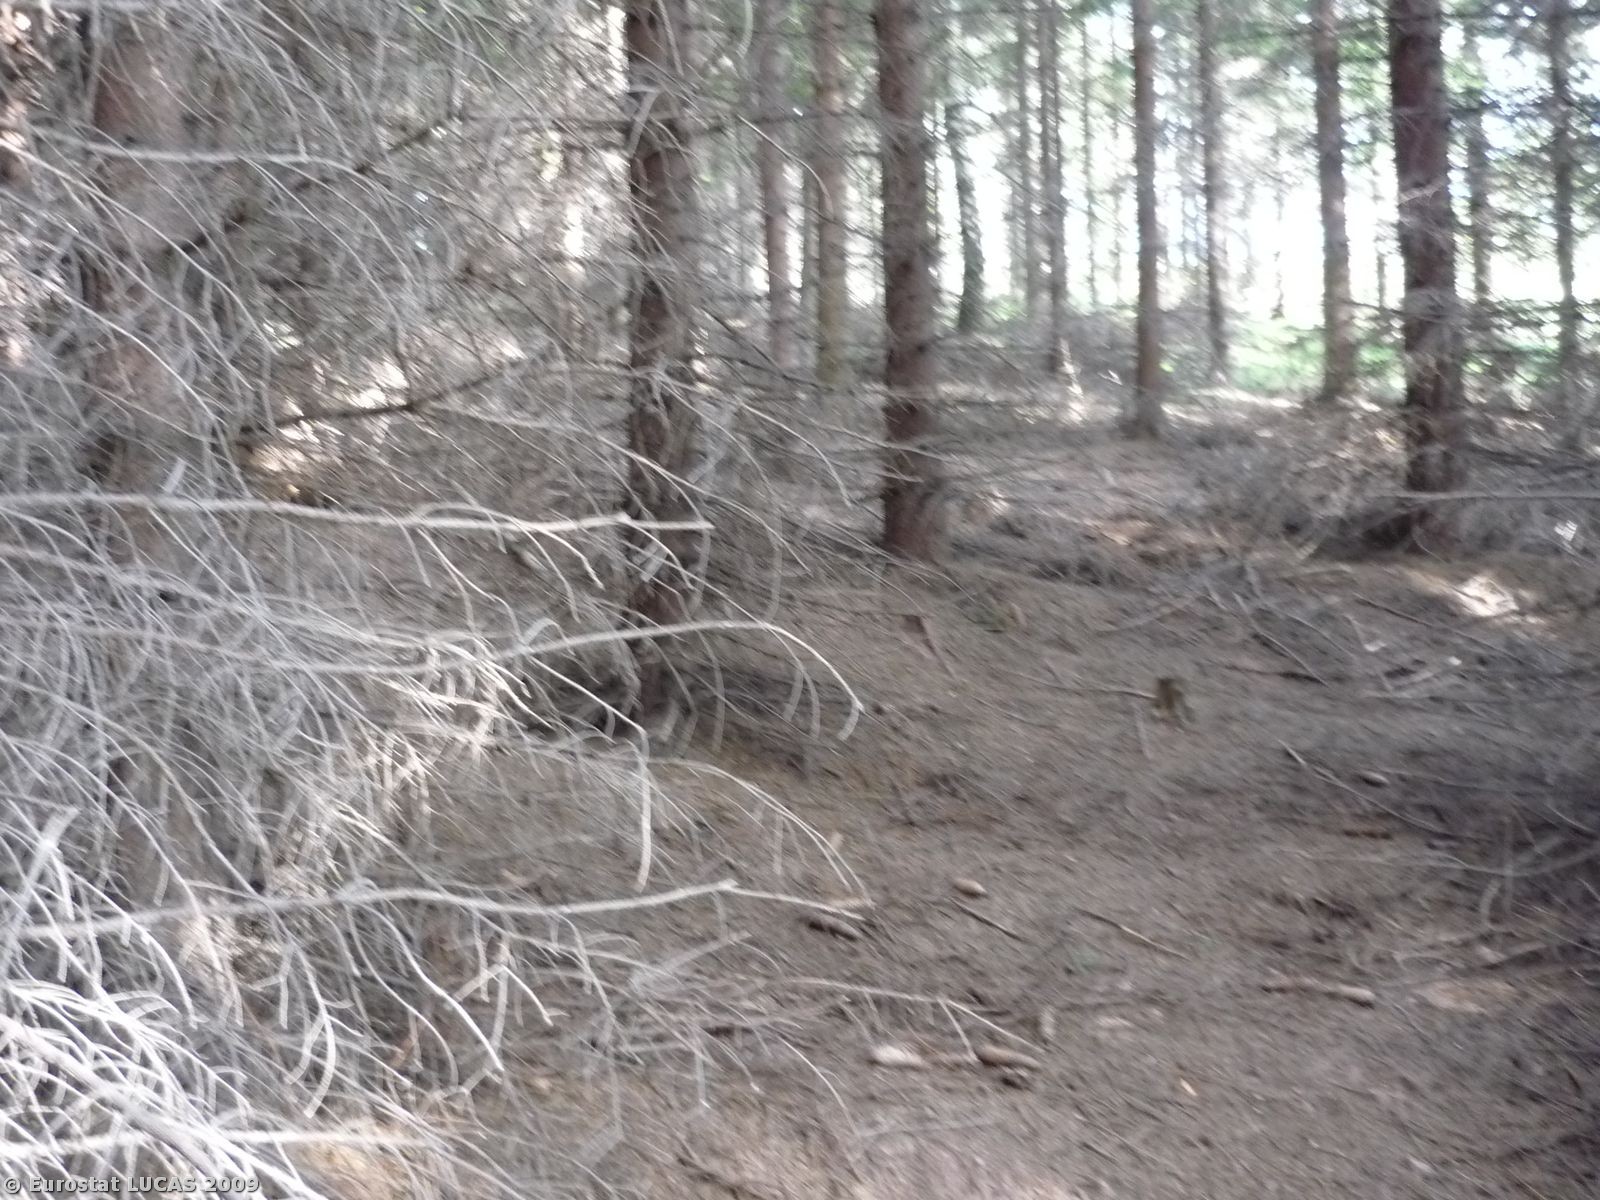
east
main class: Woodland
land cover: Coniferous woodland
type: hemiboreal forest and nemoral coniferous forest and mixed broadleaved-coniferous forest
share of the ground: > 75 %
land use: Forestry
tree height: > 5 m
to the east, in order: Coniferous woodland; Mixed woodland
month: September
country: PL
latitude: 50.7221
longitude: 16.1398
